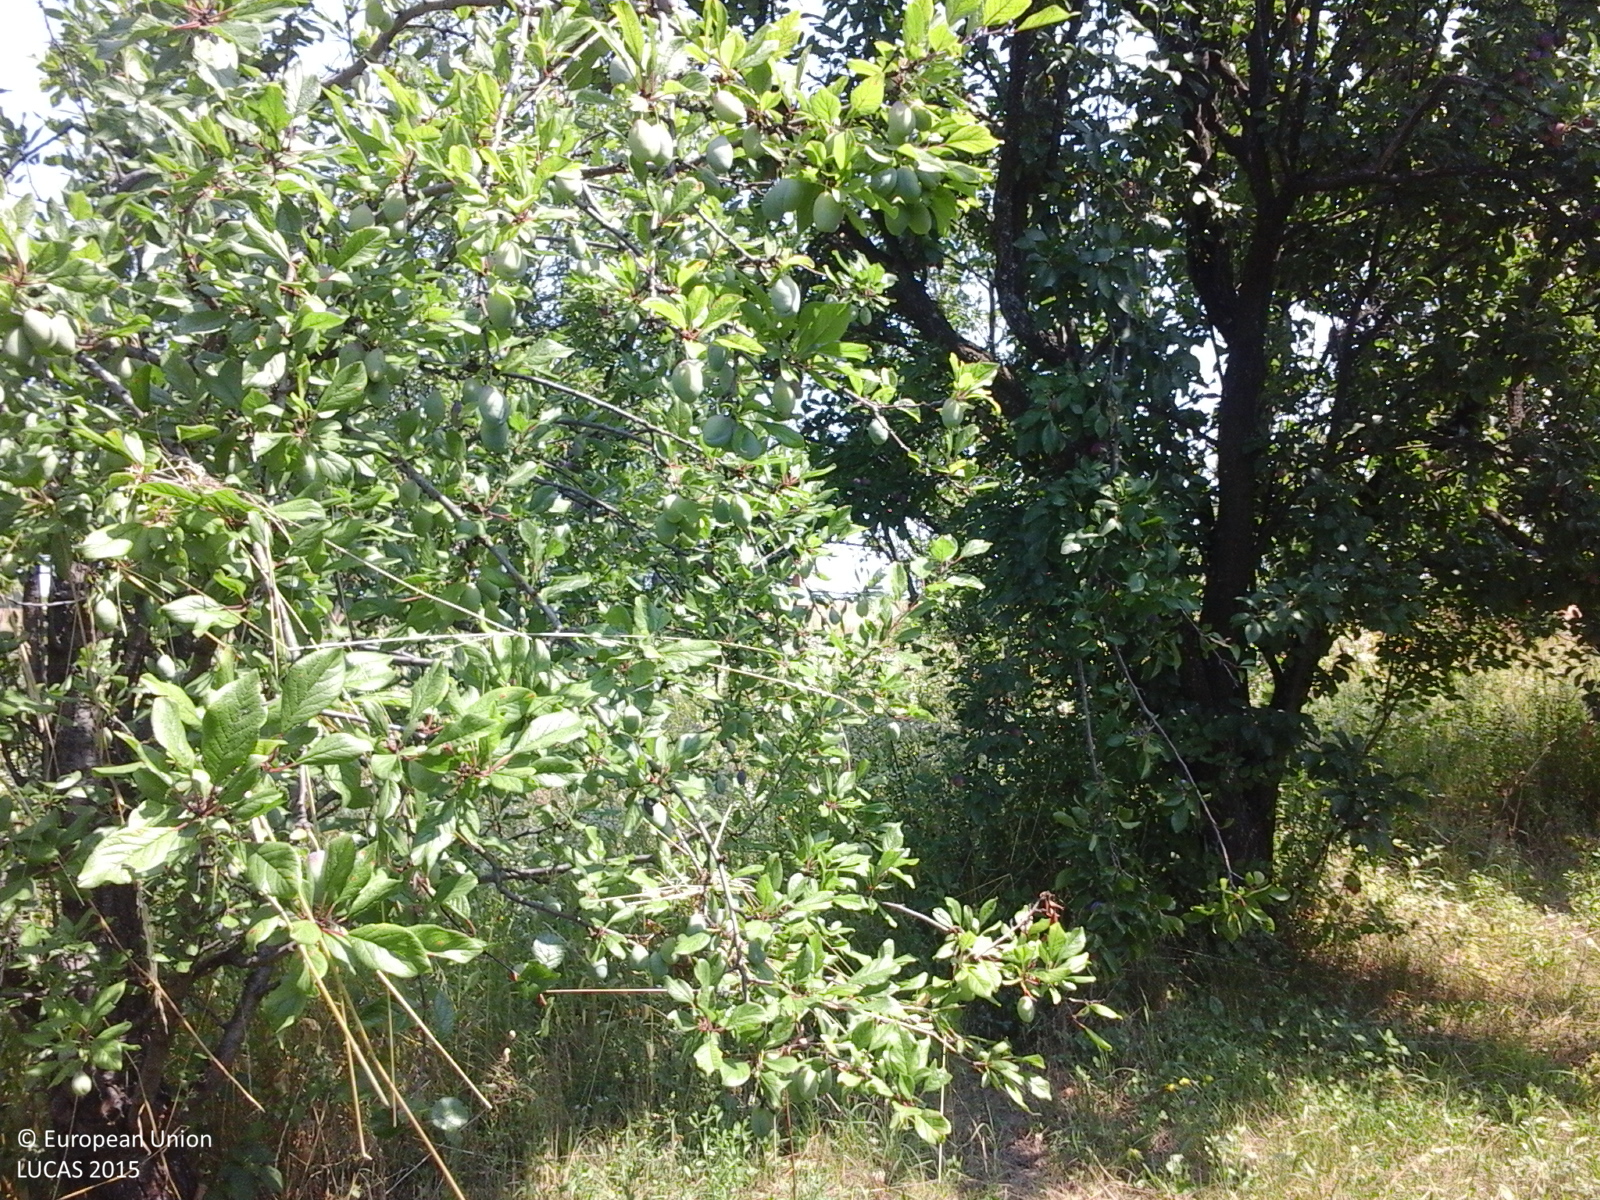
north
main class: Cropland
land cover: Other fruit trees and berries
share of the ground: > 75 %
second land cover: Grassland without tree/shrub cover
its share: 25 - 50 %
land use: Agriculture (excluding fallow land and kitchen gardens)
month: July
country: RO
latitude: 44.8333
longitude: 25.4629
